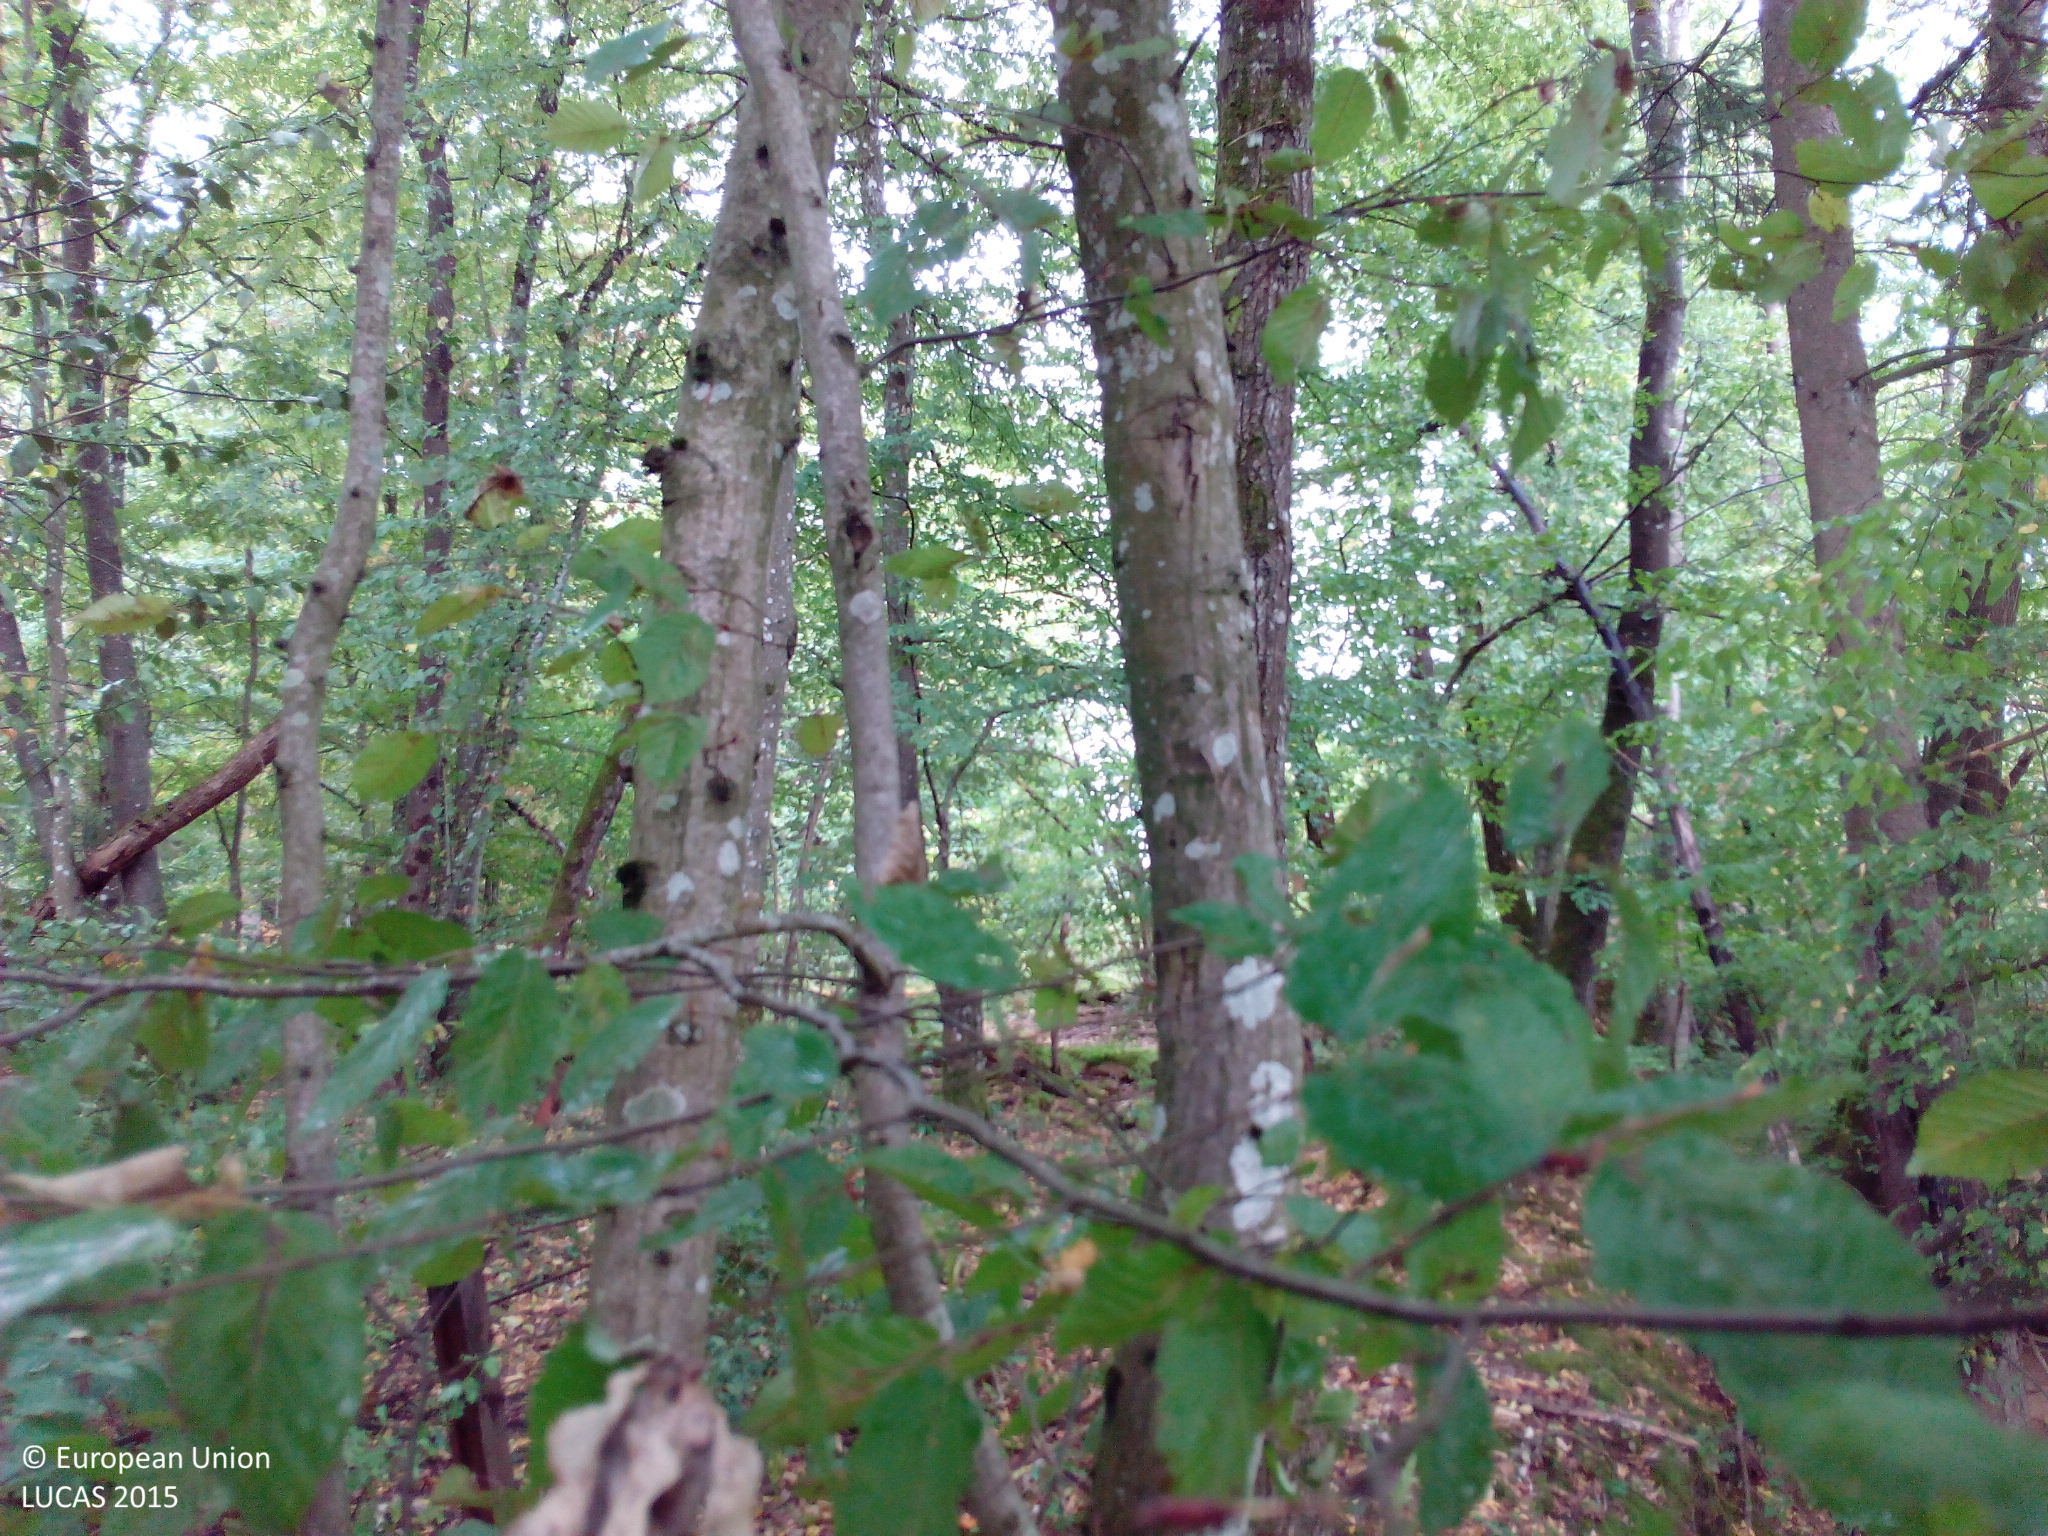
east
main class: Woodland
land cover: Broadleaved woodland
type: beech forest
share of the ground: > 75 %
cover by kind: broadleaved forest trees 80 %, herbaceous plants 20 %
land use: Abandoned areas
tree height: > 5 m
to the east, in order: Broadleaved woodland; Grassland with sparse tree/shrub cover; Spontaneously vegetated surfaces; Tracks; Spontaneously vegetated surfaces; Broadleaved woodland; Artificial constructions in urban areas
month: August
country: DE
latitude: 47.5956
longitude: 8.1262
